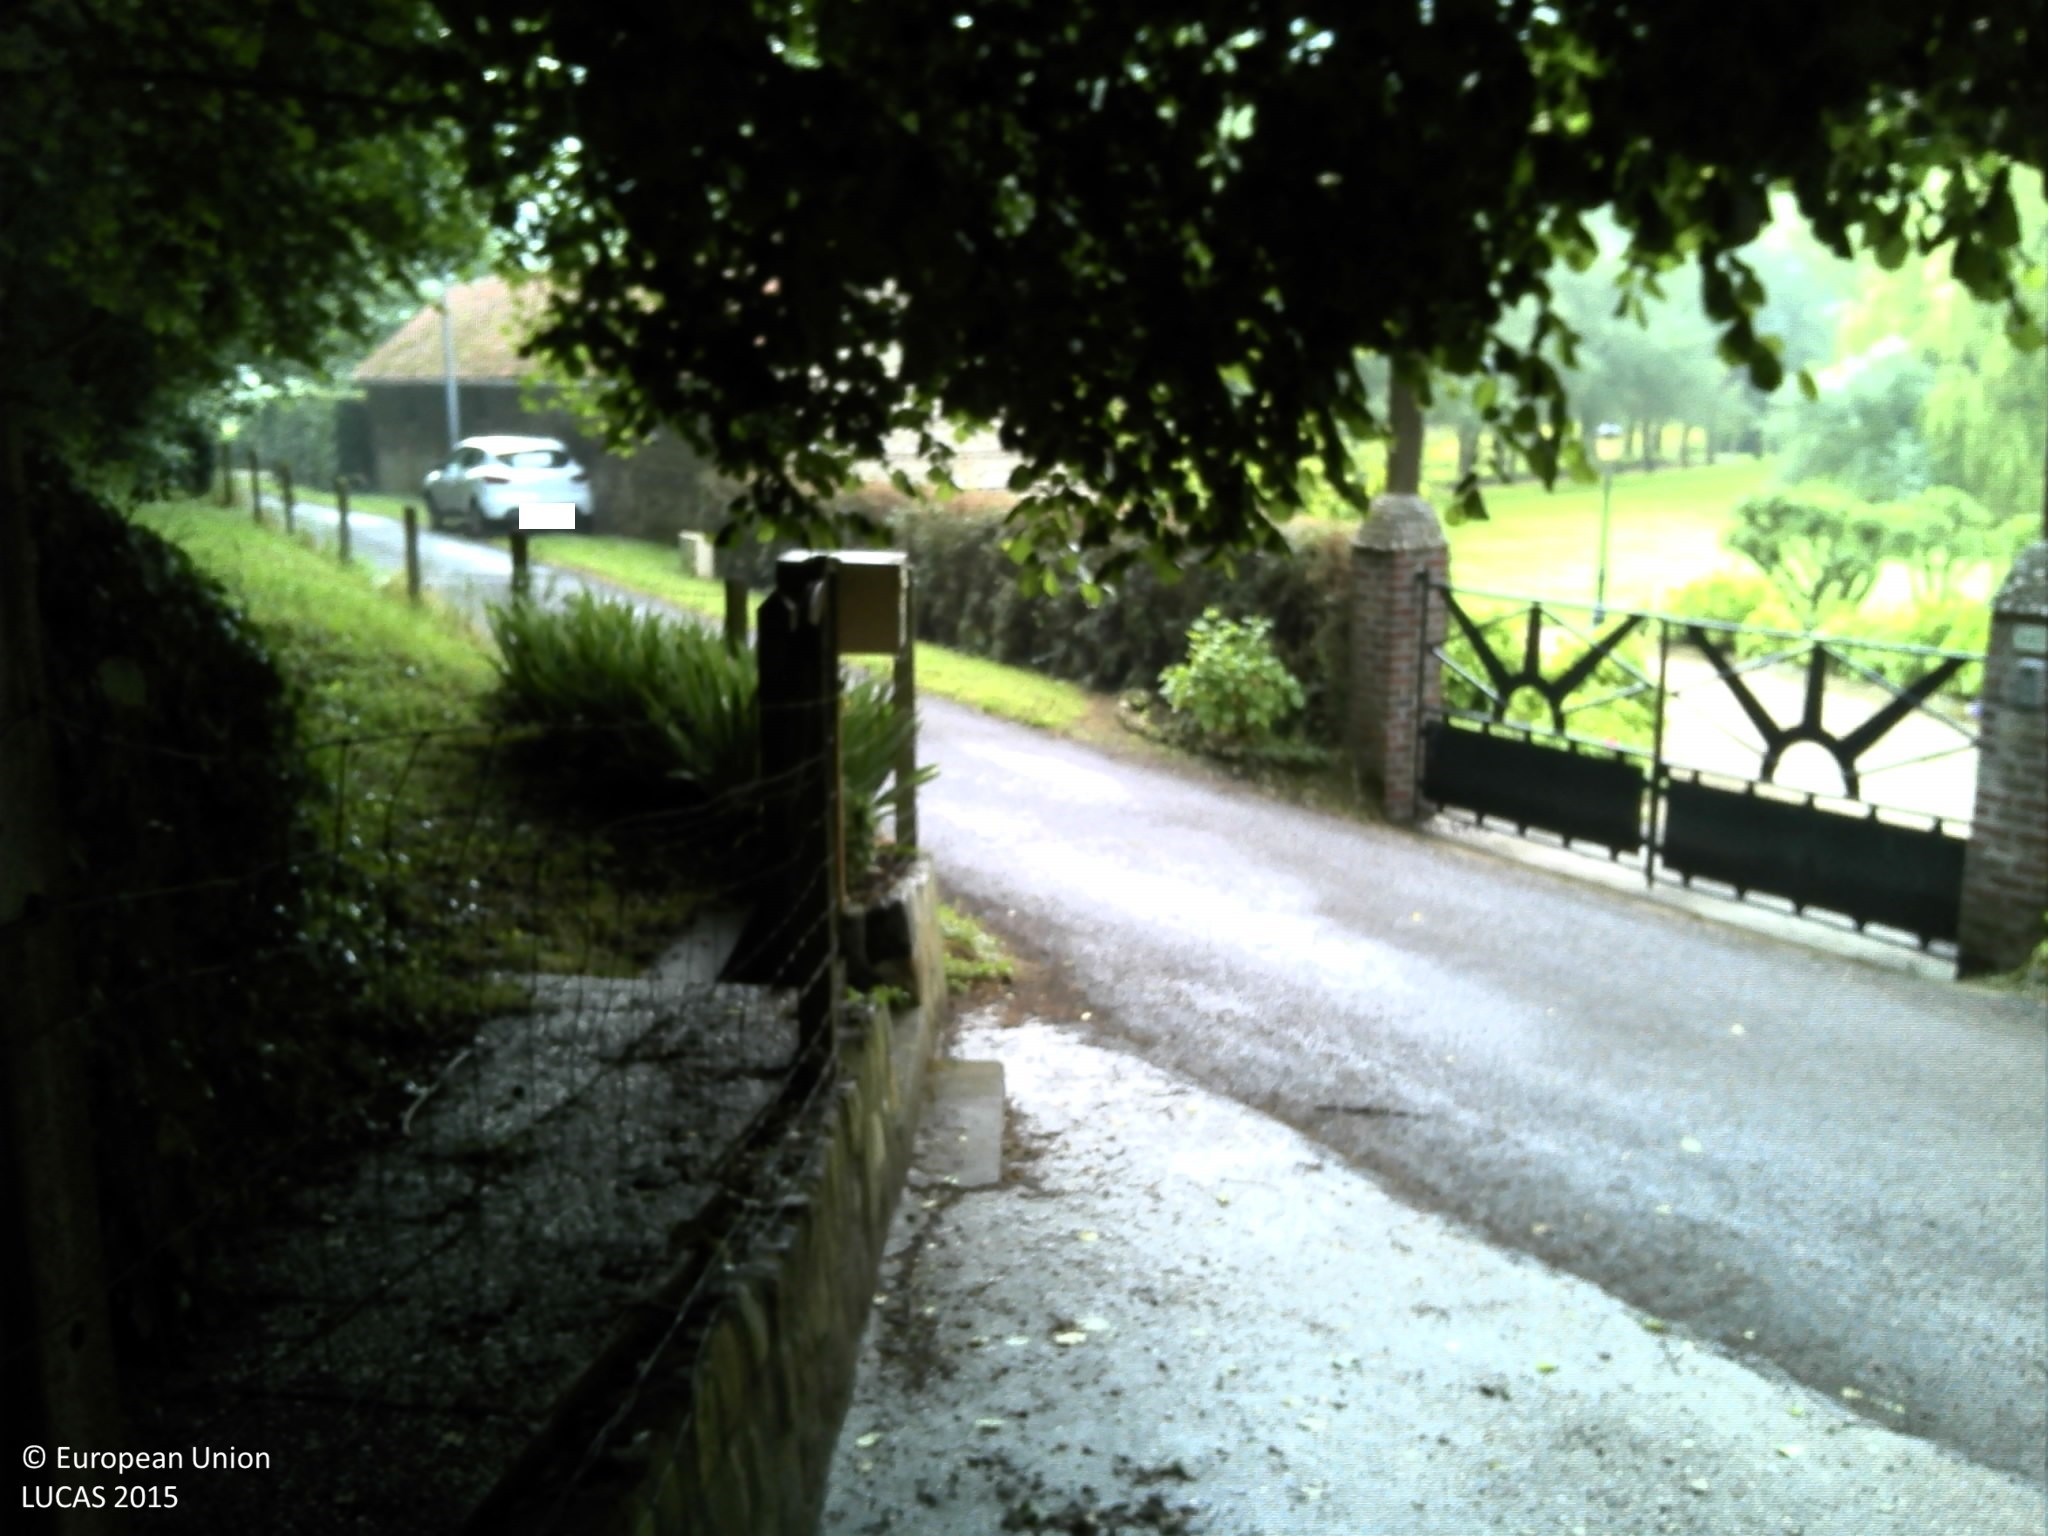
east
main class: Woodland
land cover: Broadleaved woodland
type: mesophytic deciduous forest
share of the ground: > 75 %
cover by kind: broadleaved forest trees 95 %, herbaceous plants 5 %
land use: Residential
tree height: > 5 m
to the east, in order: Broadleaved woodland; Fences; Paved roads, cycling and walking lanes; Fences; Grassland without tree/shrub cover; Lines of trees; Tracks; Lines of trees; Grassland without tree/shrub cover
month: June
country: FR
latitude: 49.4974
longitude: 0.2925
